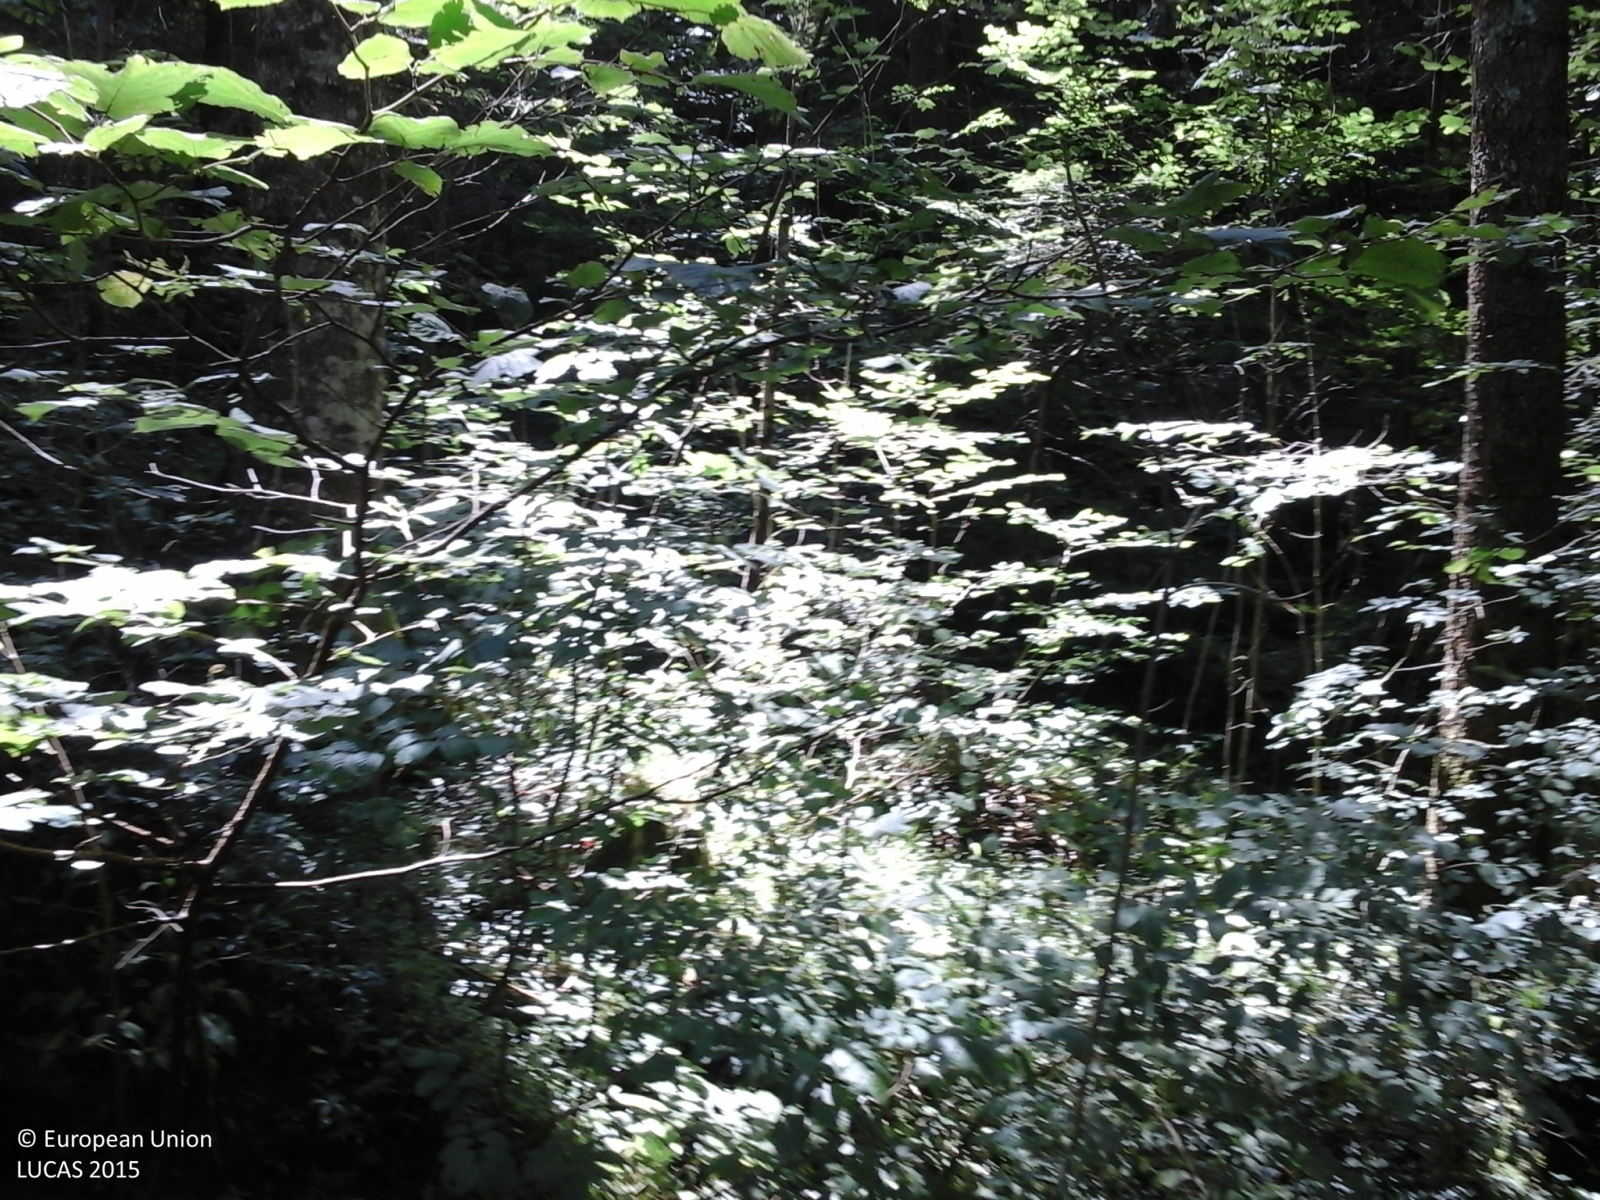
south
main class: Woodland
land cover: Spruce dominated mixed woodland
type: alpine coniferous forest
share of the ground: > 75 %
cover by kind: coniferous forest trees 75 %, broadleaved forest trees 25 %
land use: Semi-natural and natural areas not in use
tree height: > 5 m
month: July
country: IT
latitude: 45.9728
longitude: 10.1160
